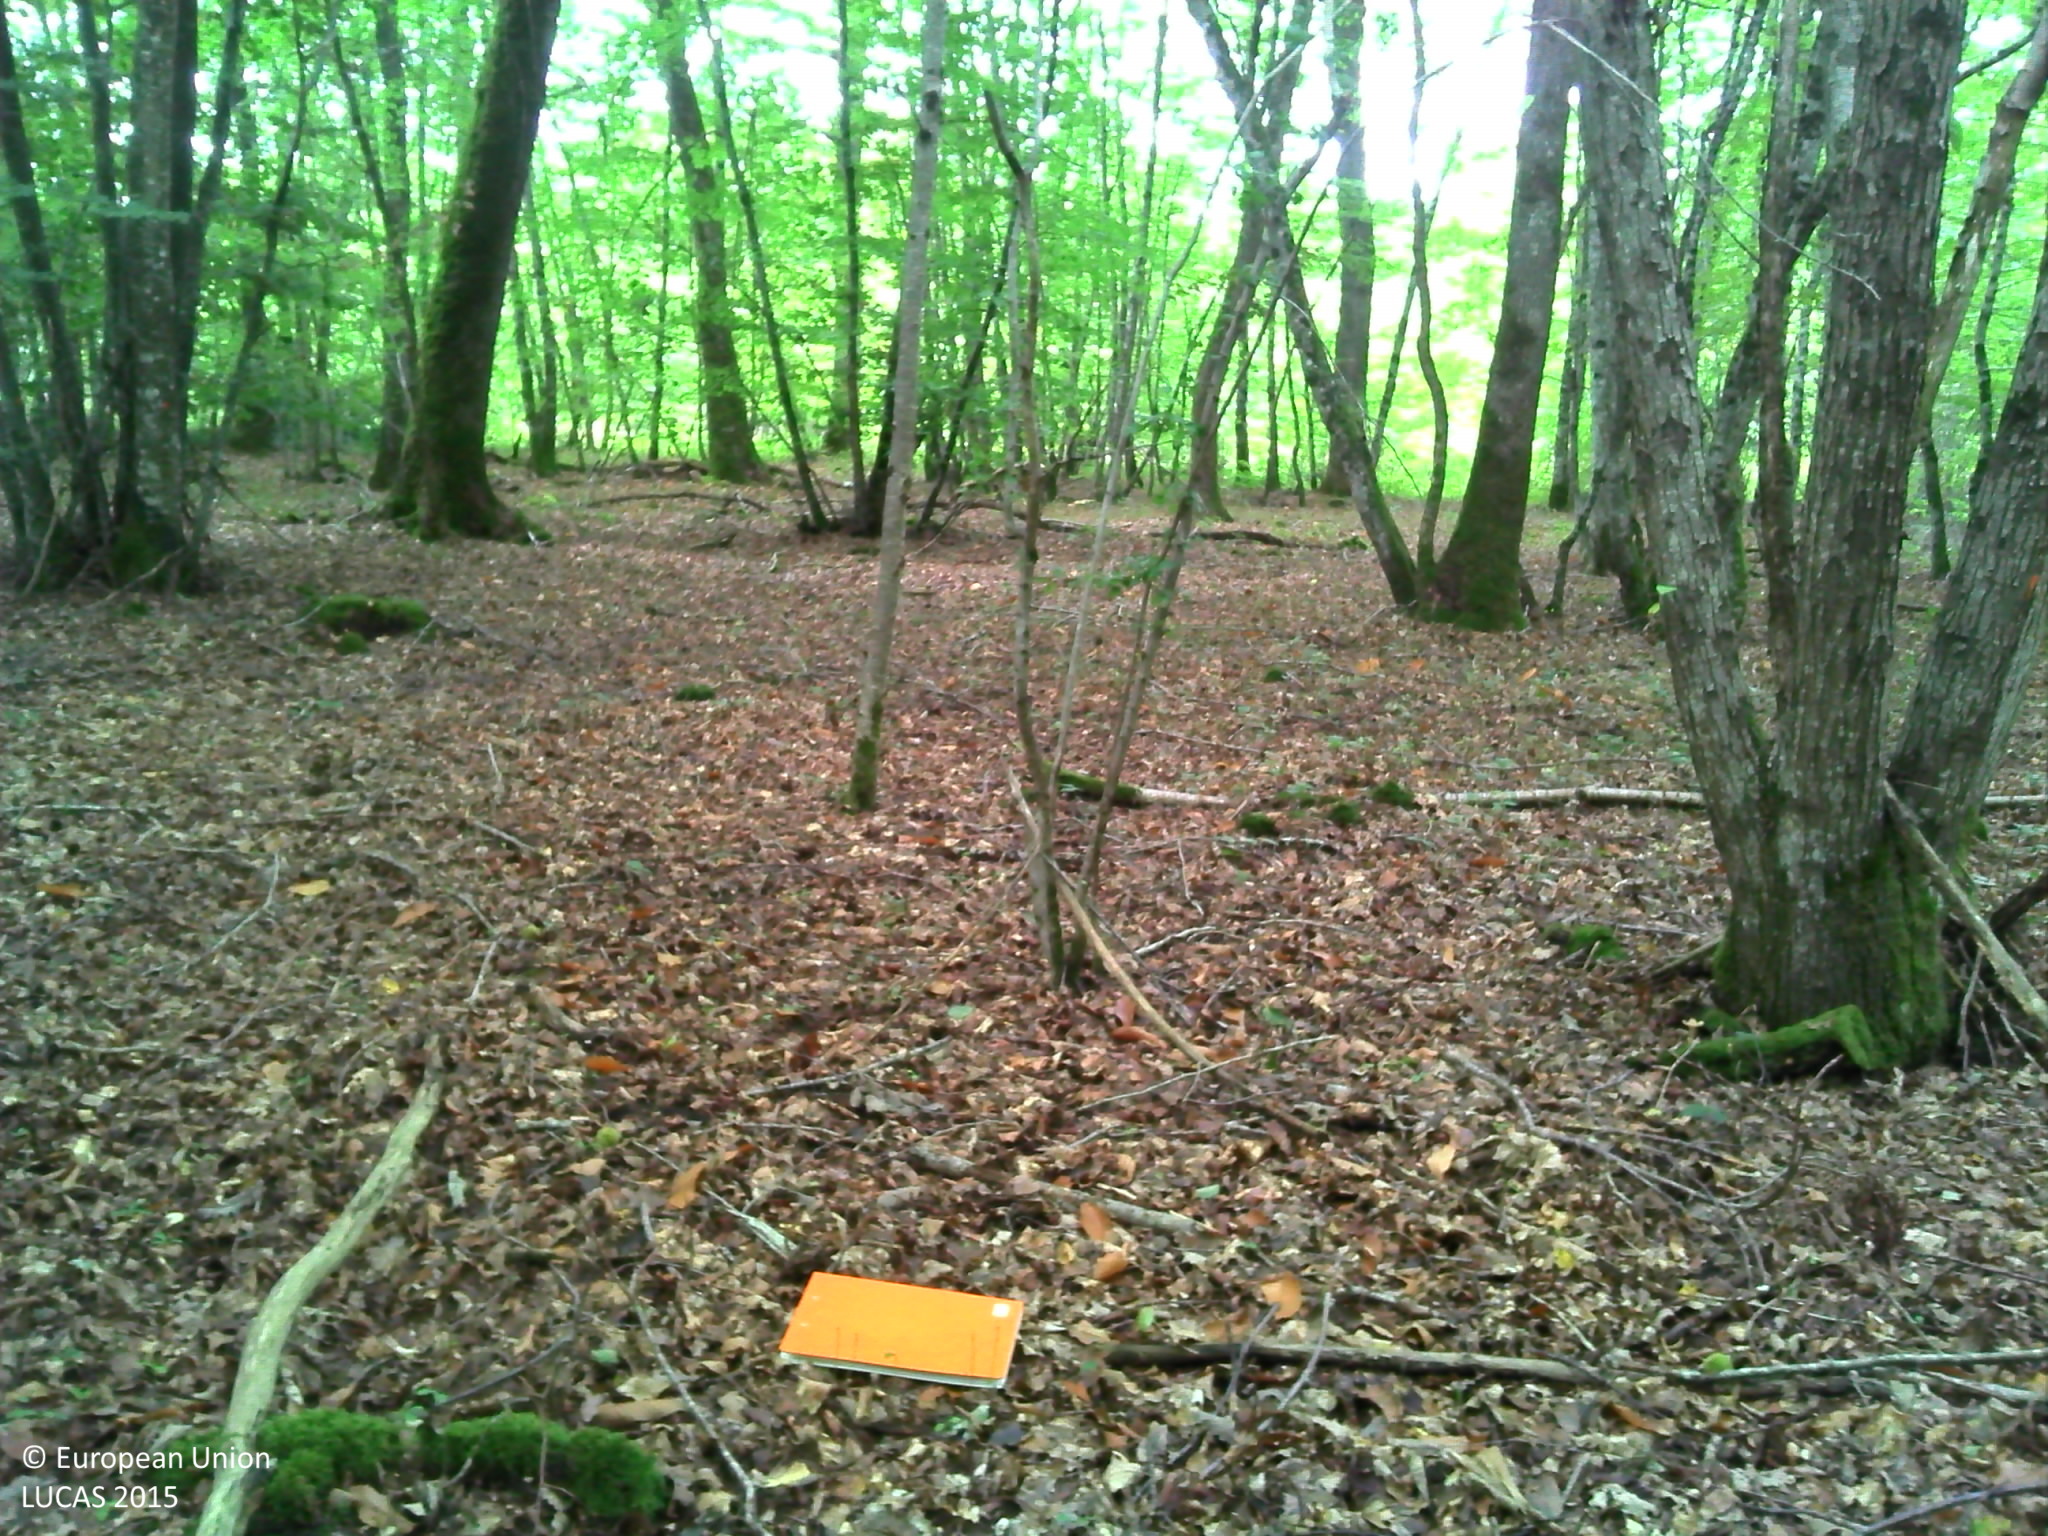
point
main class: Woodland
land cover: Broadleaved woodland
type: mesophytic deciduous forest
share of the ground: > 75 %
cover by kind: broadleaved forest trees 90 %, unconsolidated bare surface 10 %
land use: Forestry
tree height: > 5 m
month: June
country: FR
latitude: 47.1305
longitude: 2.6772
